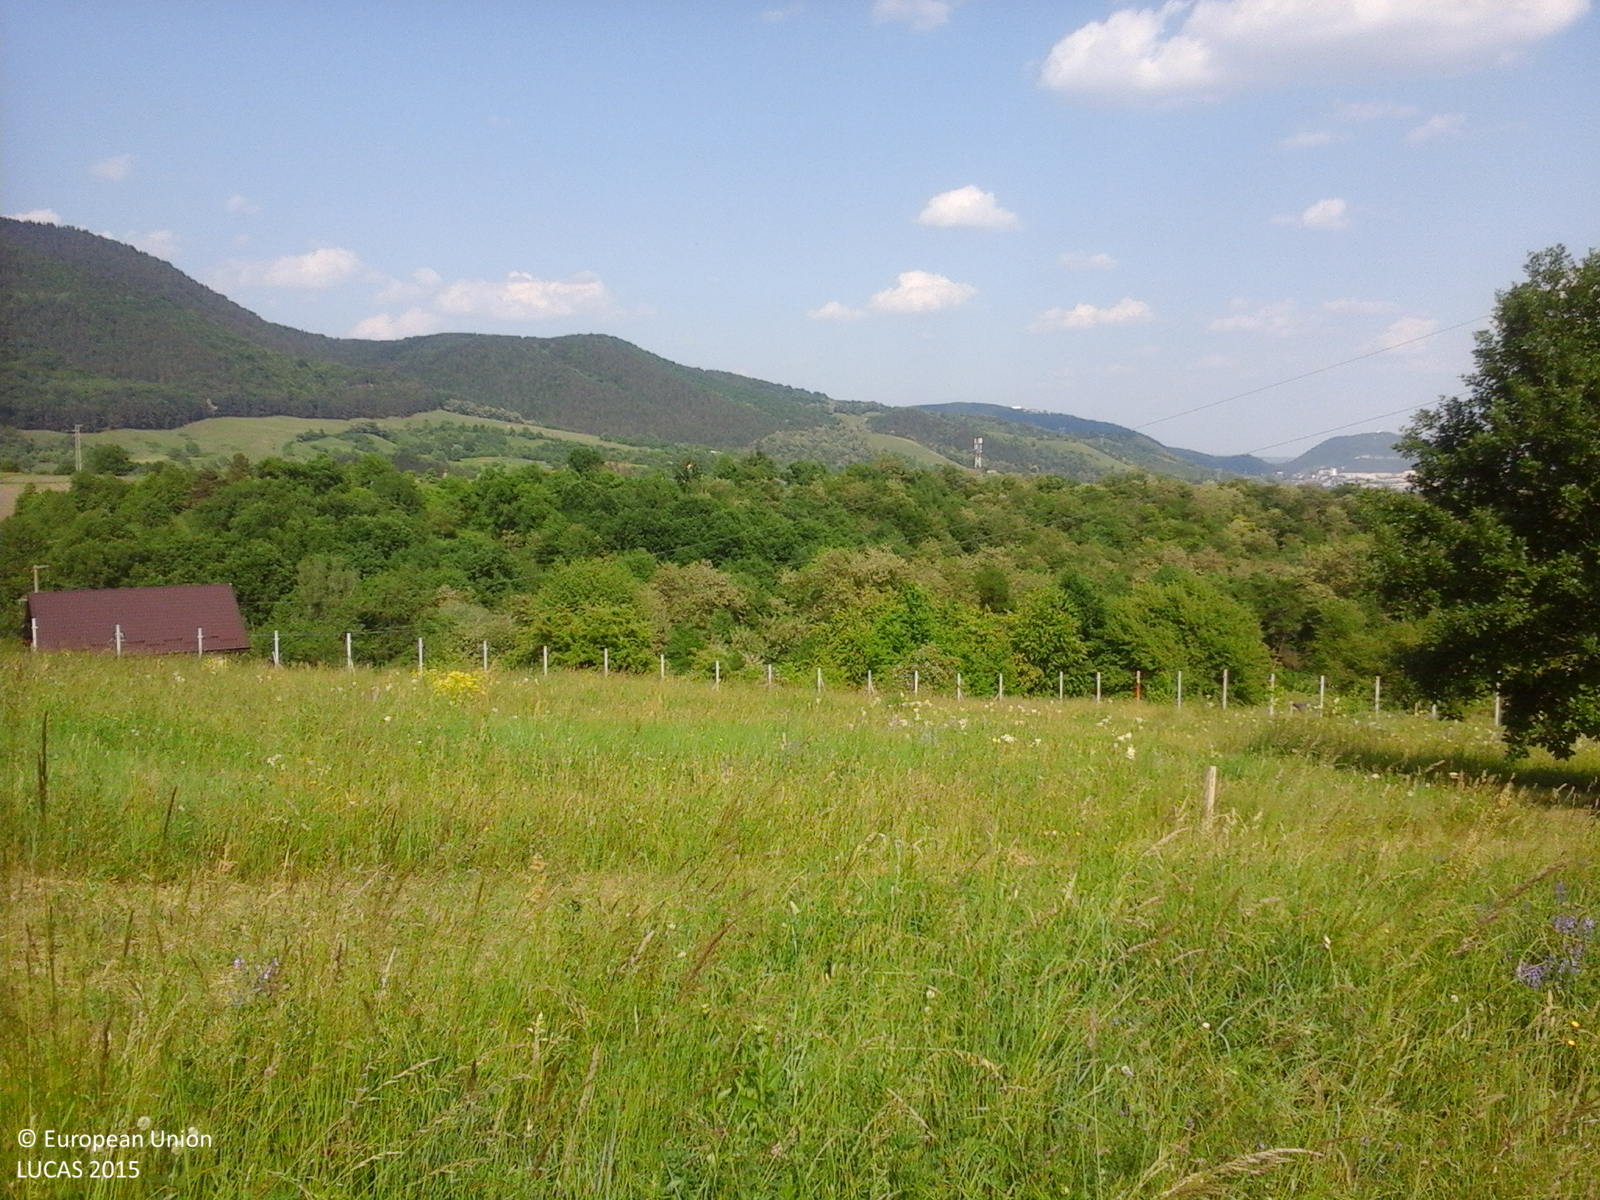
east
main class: Cropland
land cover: Other leguminous and mixtures for fodder
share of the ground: > 75 %
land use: Agriculture (excluding fallow land and kitchen gardens)
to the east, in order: Other leguminous and mixtures for fodder; Tracks; Other leguminous and mixtures for fodder; Fences; Other leguminous and mixtures for fodder; Electric lines; Other leguminous and mixtures for fodder; Fences; Other fruit trees and berries; Tracks; Broadleaved woodland
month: June
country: RO
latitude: 46.9477
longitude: 26.2788
